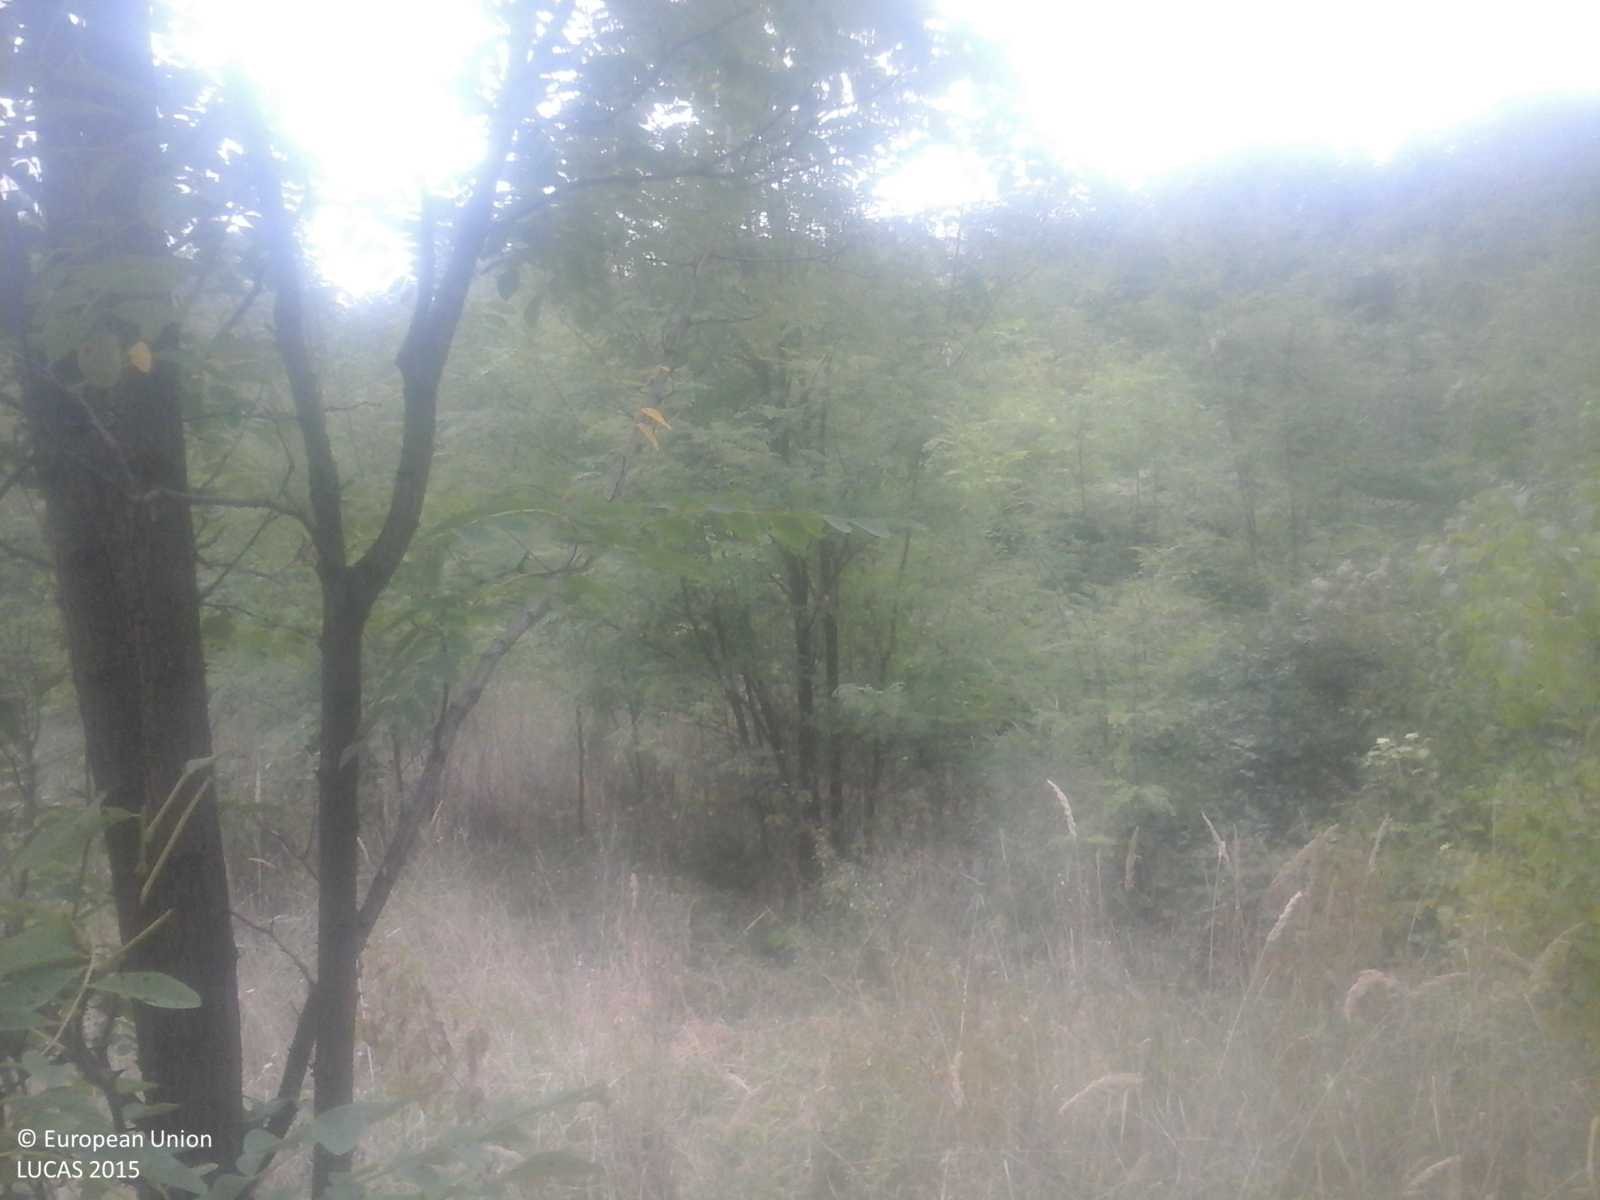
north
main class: Woodland
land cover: Broadleaved woodland
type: exotic forest
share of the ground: > 75 %
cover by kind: broadleaved forest trees 100 %
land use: Forestry
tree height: > 5 m
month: September
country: RO
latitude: 44.7832
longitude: 23.1817
